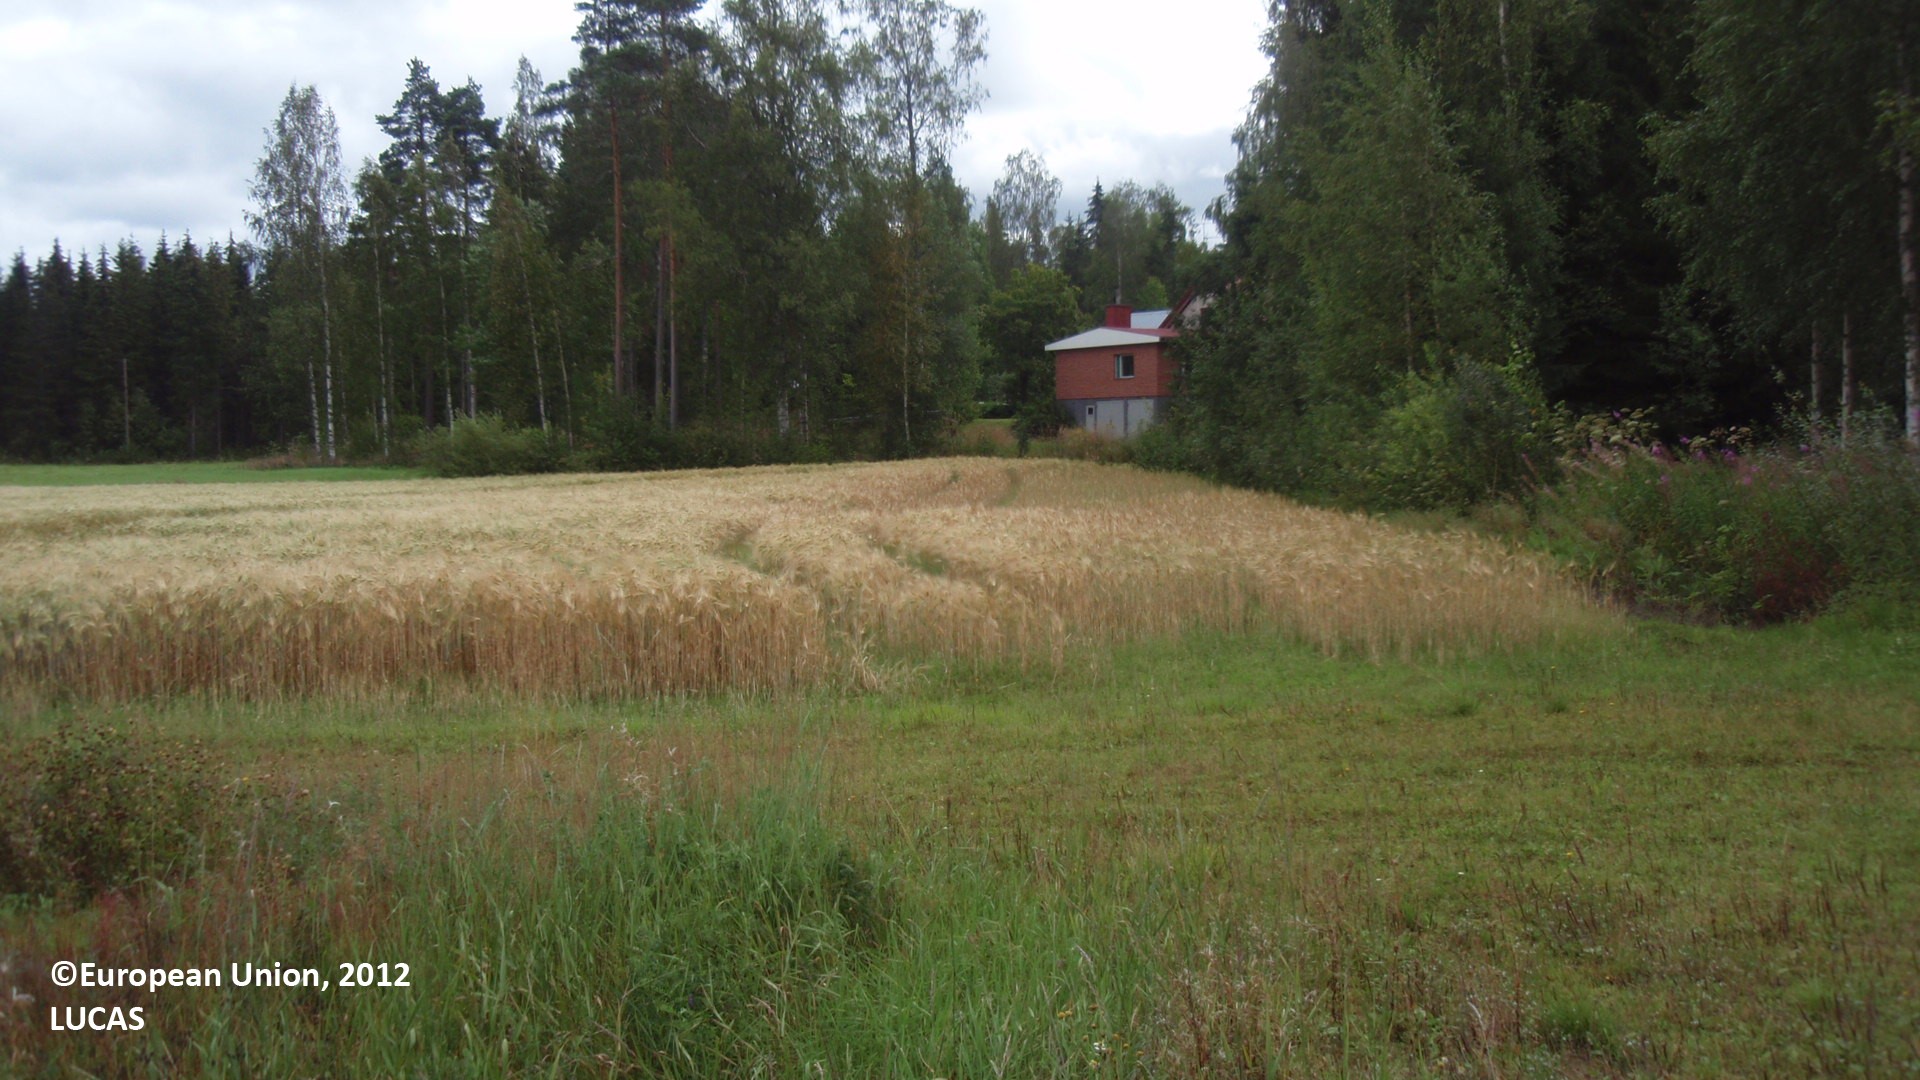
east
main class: Cropland
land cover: Barley
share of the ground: > 75 %
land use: Agriculture (excluding fallow land and kitchen gardens)
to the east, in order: Barley; Grass margins; Tracks; Barley; Artificial constructions in urban areas; Spruce dominated mixed woodland
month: August
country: FI
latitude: 60.8941
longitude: 26.9934
